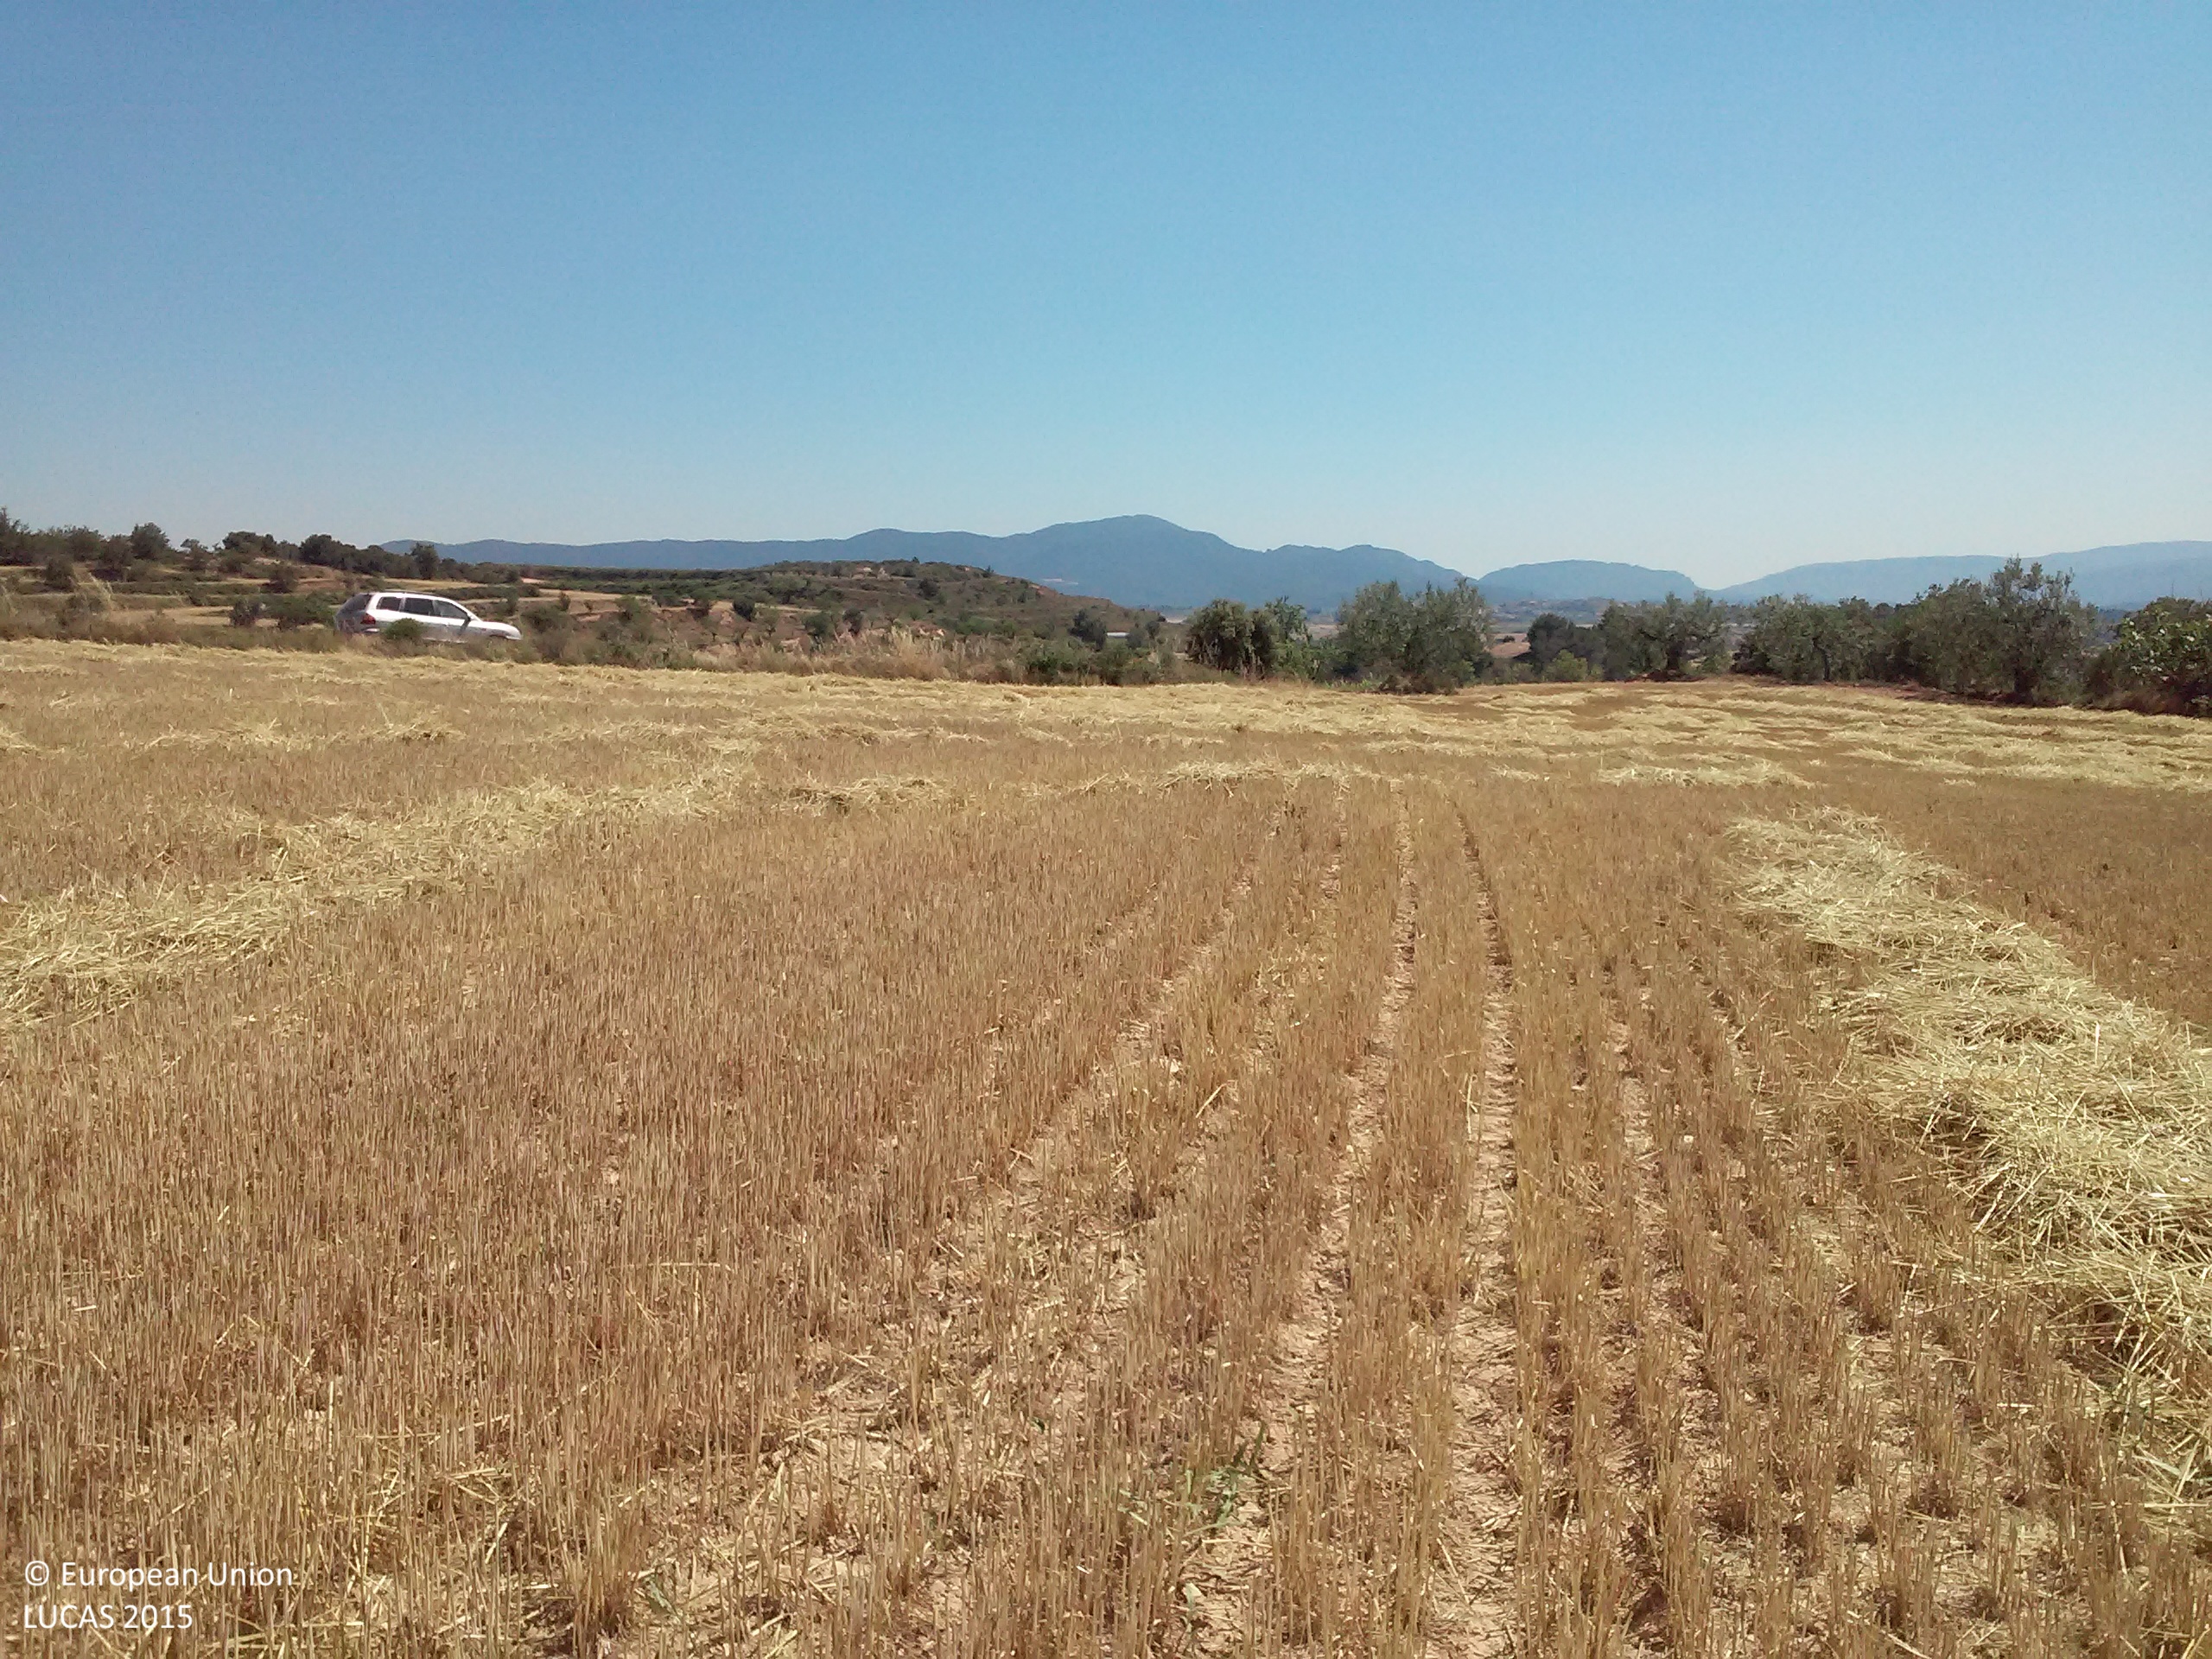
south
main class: Cropland
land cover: Barley
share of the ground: < 10 %
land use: Agriculture (excluding fallow land and kitchen gardens)
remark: Harvested field
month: June
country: ES
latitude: 41.4566
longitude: 1.2402
